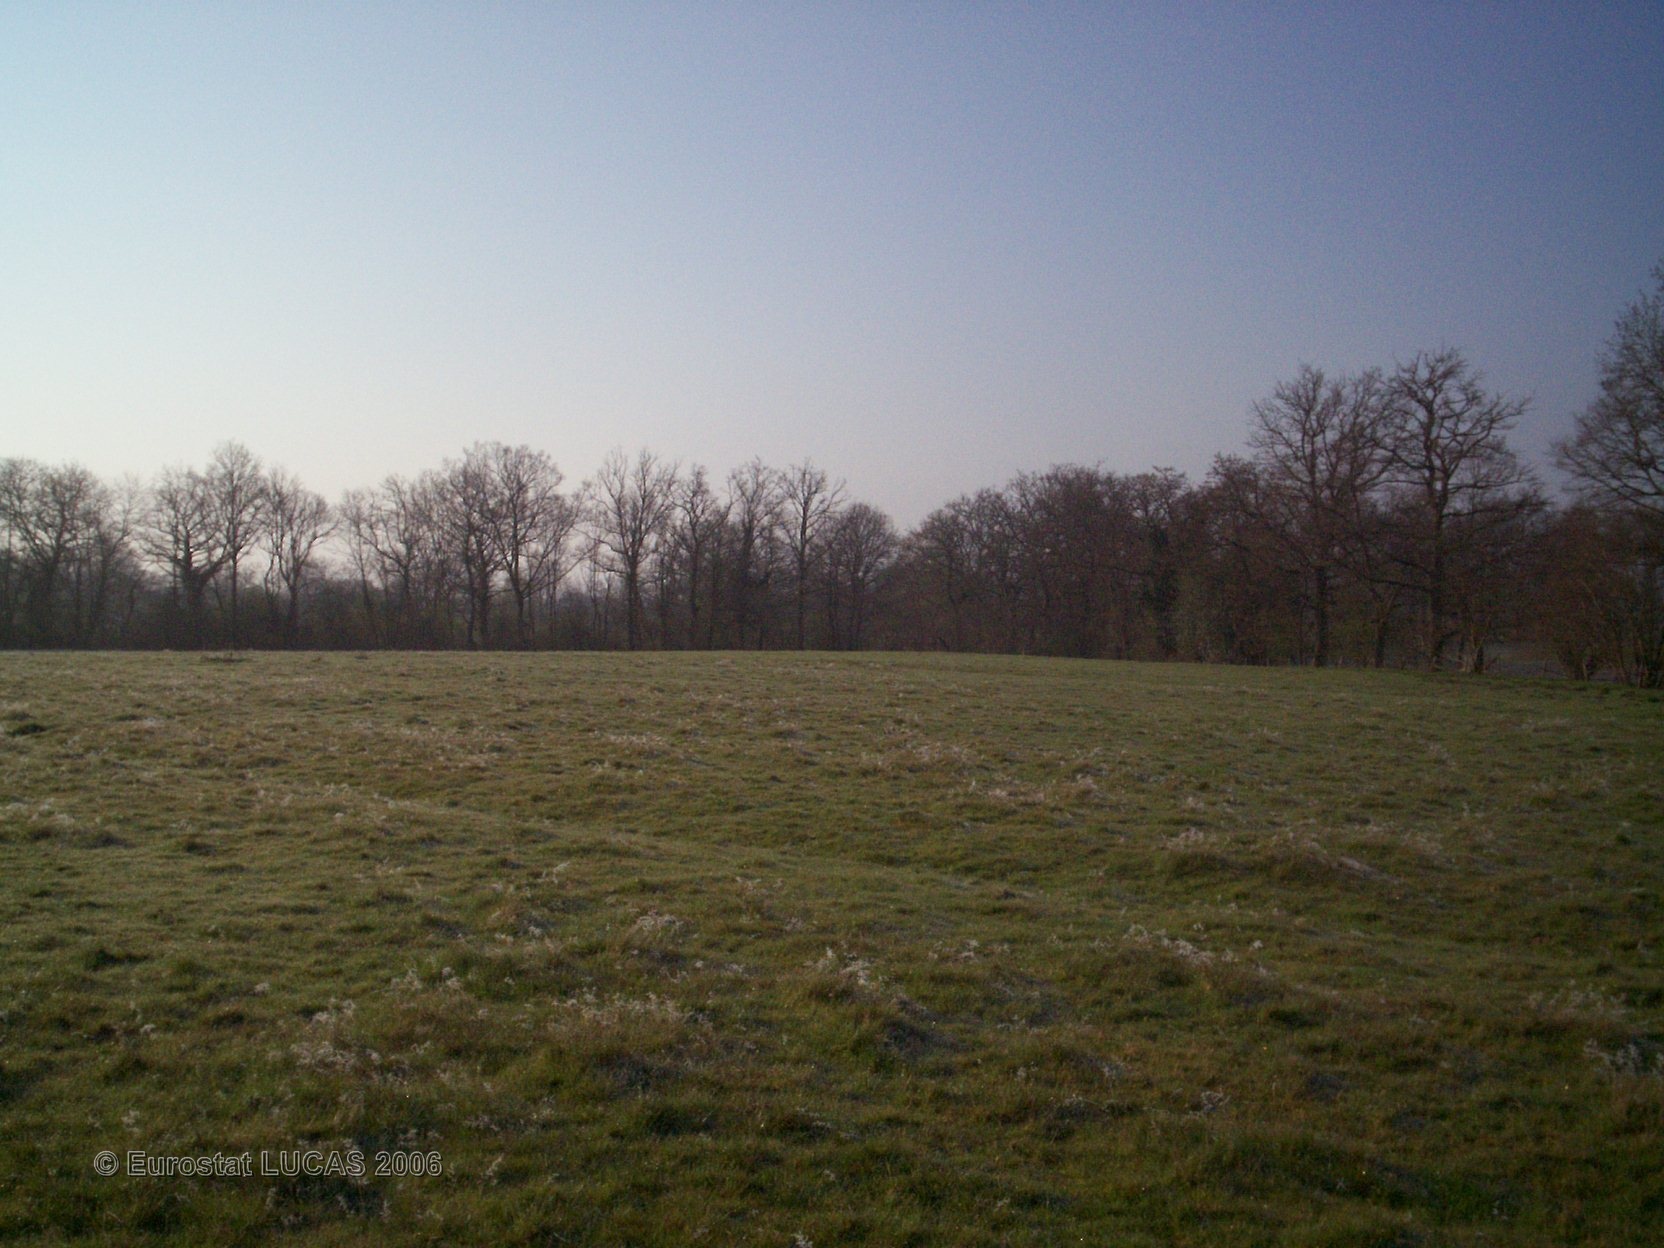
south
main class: Grassland
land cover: Grassland without tree/shrub cover
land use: Agriculture (excluding fallow land and kitchen gardens)
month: April
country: FR
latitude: 46.2516
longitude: 1.1027
